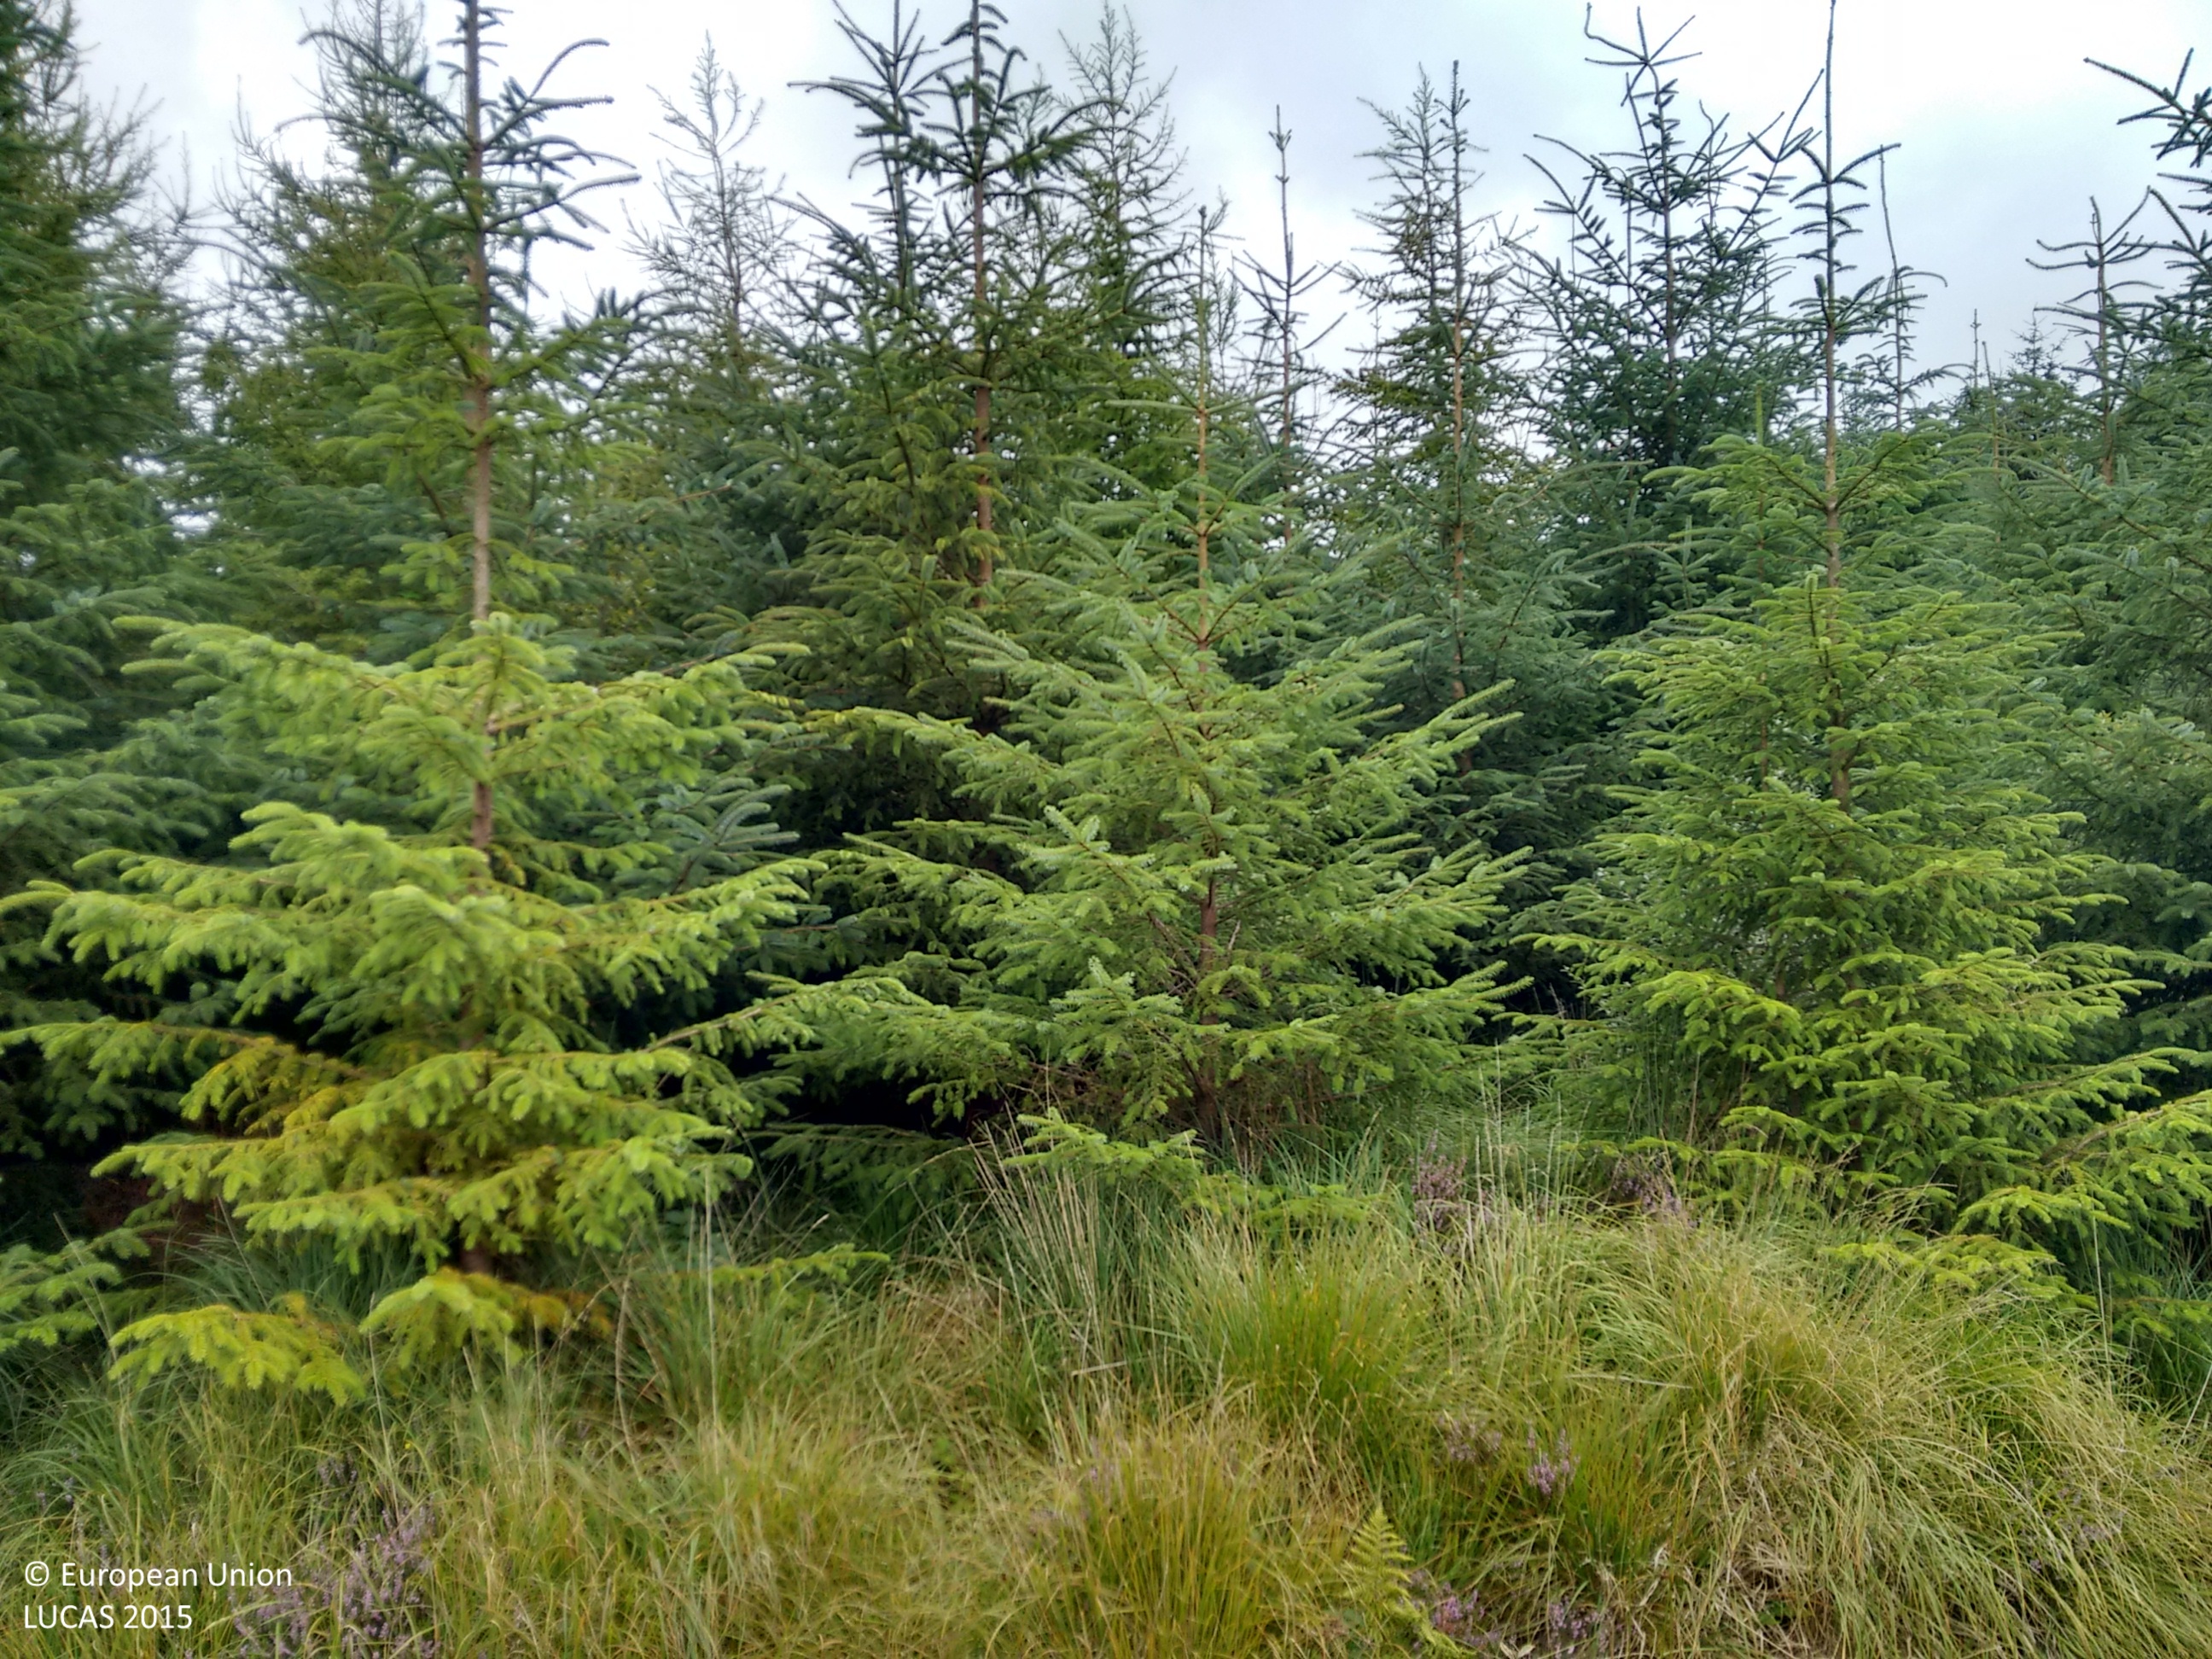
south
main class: Woodland
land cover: Spruce dominated coniferous woodland
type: exotic forest
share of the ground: > 75 %
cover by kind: coniferous forest trees 95 %, herbaceous plants 5 %
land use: Forestry
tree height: > 5 m
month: September
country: IE
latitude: 52.7993
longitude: -9.1286
